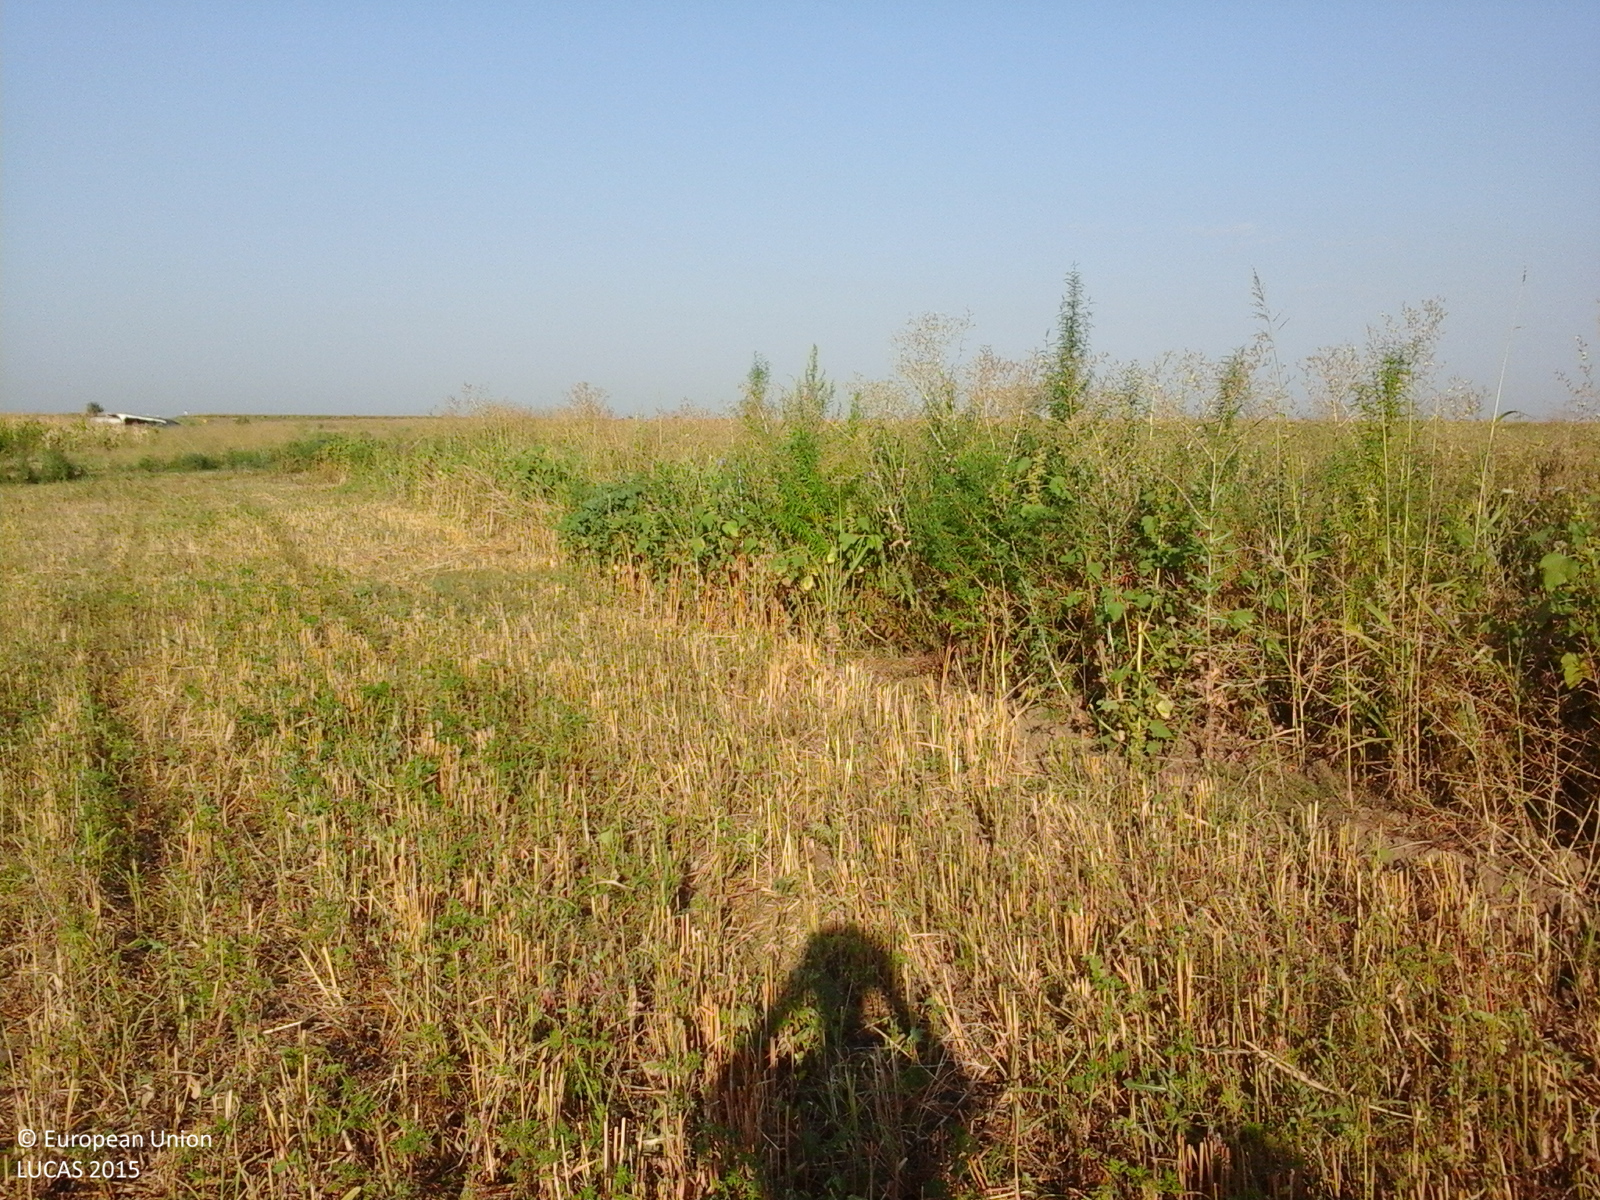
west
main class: Cropland
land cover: Oats
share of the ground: > 75 %
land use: Agriculture (excluding fallow land and kitchen gardens)
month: August
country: RO
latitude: 44.0669
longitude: 23.2168
